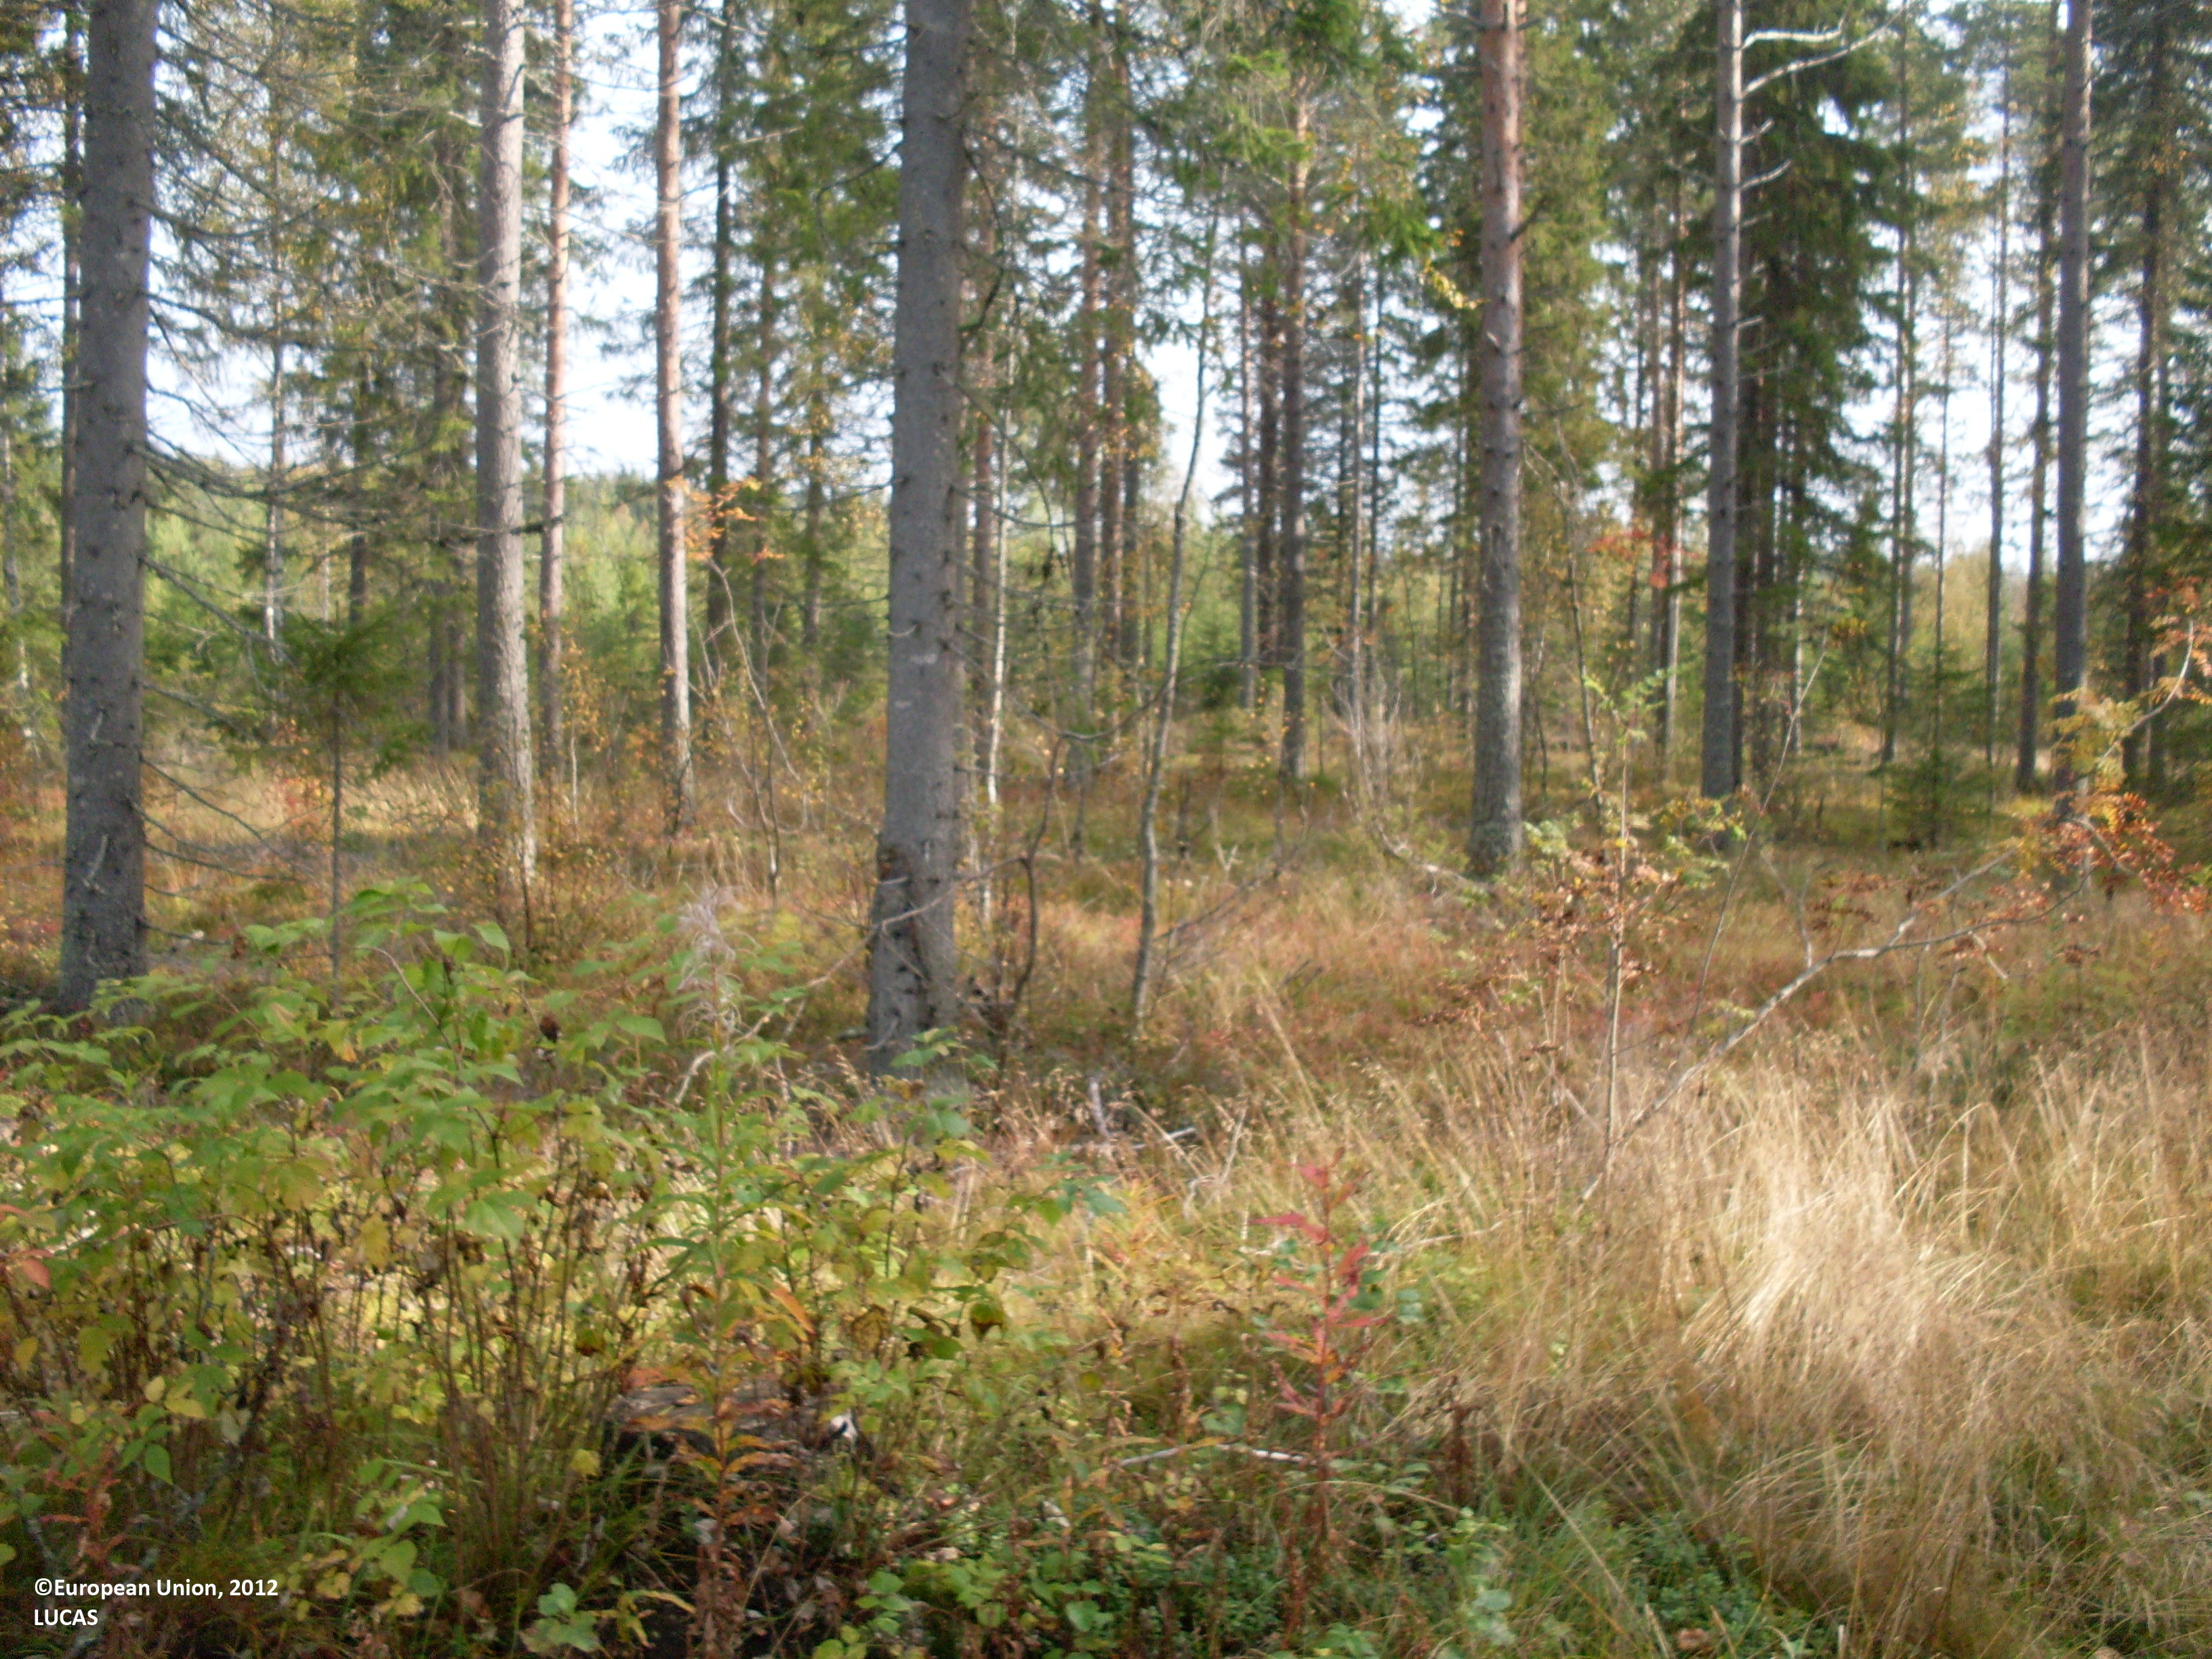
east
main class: Woodland
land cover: Other mixed woodland
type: boreal forest
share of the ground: 50 - 75 %
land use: Forestry
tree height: > 5 m
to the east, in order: Other mixed woodland; Spruce dominated mixed woodland
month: September
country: FI
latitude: 64.2341
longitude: 29.3665
